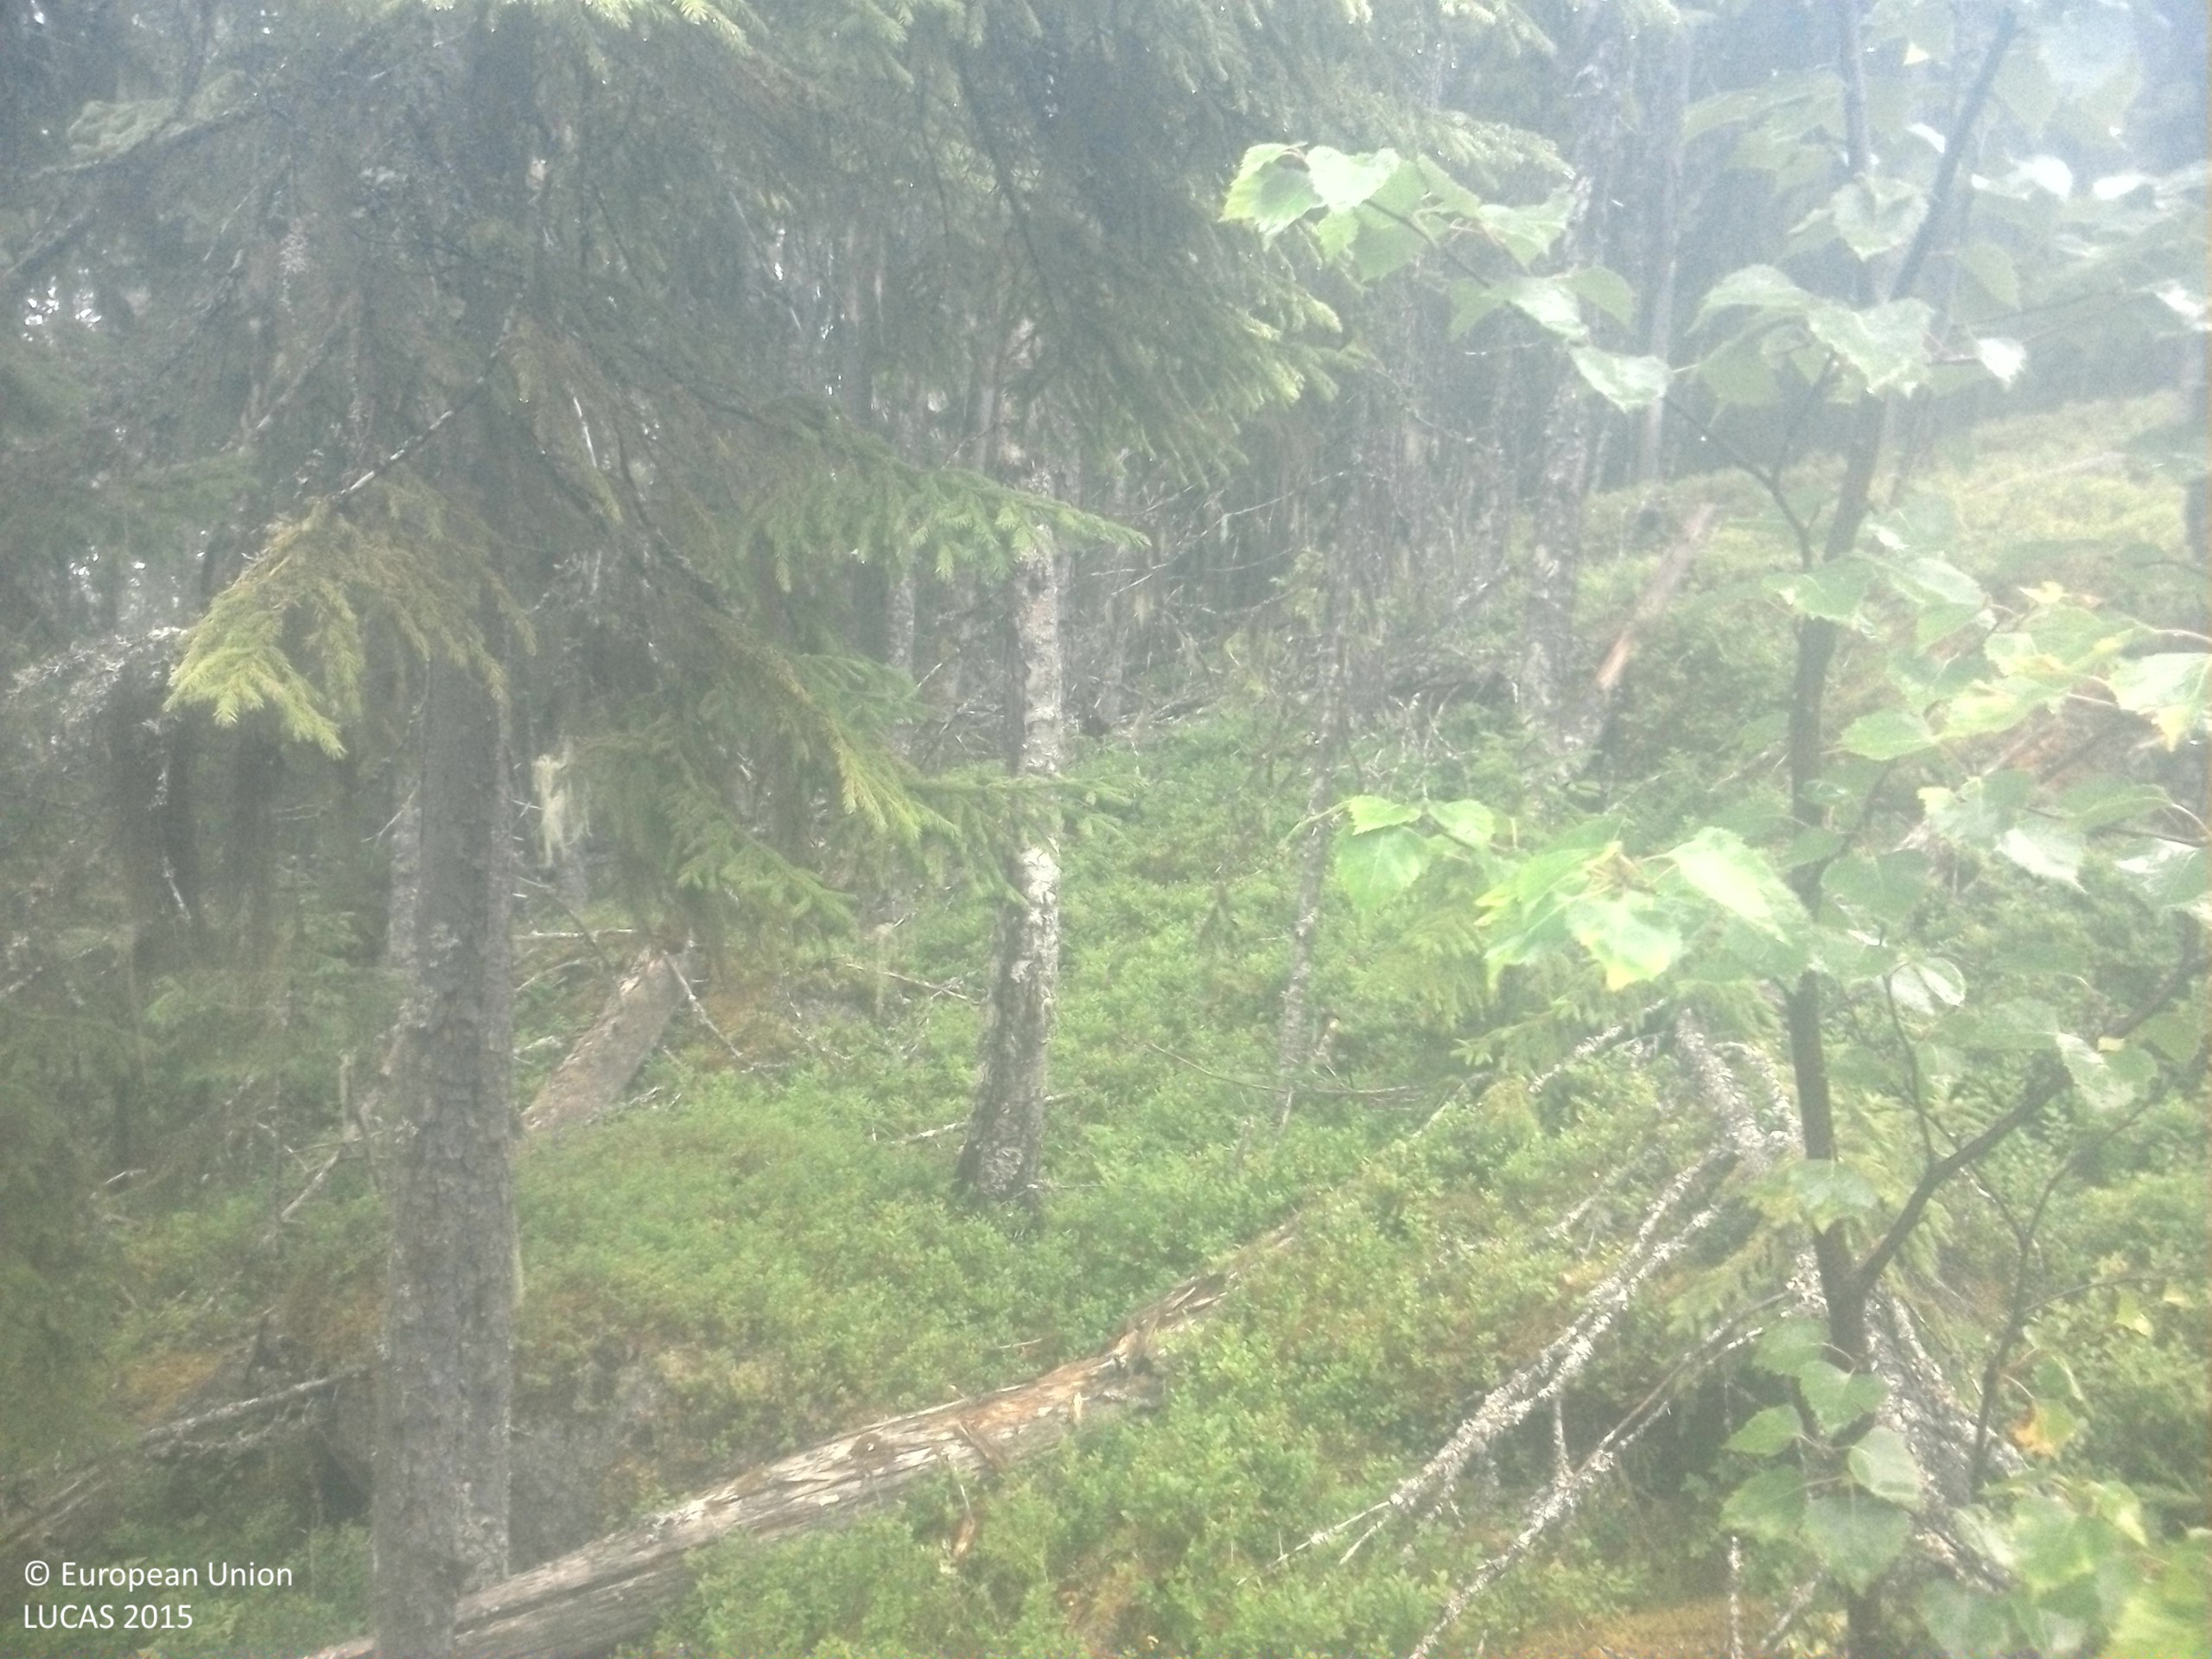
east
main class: Woodland
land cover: Spruce dominated mixed woodland
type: boreal forest
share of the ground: 50 - 75 %
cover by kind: coniferous forest trees 45 %, shrubs 20 %, broadleaved forest trees 15 %, lichens and mosses 10 %, herbaceous plants 5 %, consolidated bare surface 5 %
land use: Forestry
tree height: > 5 m
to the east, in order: Spruce dominated mixed woodland; Spruce dominated coniferous woodland
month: August
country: SE
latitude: 63.5431
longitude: 16.4315
